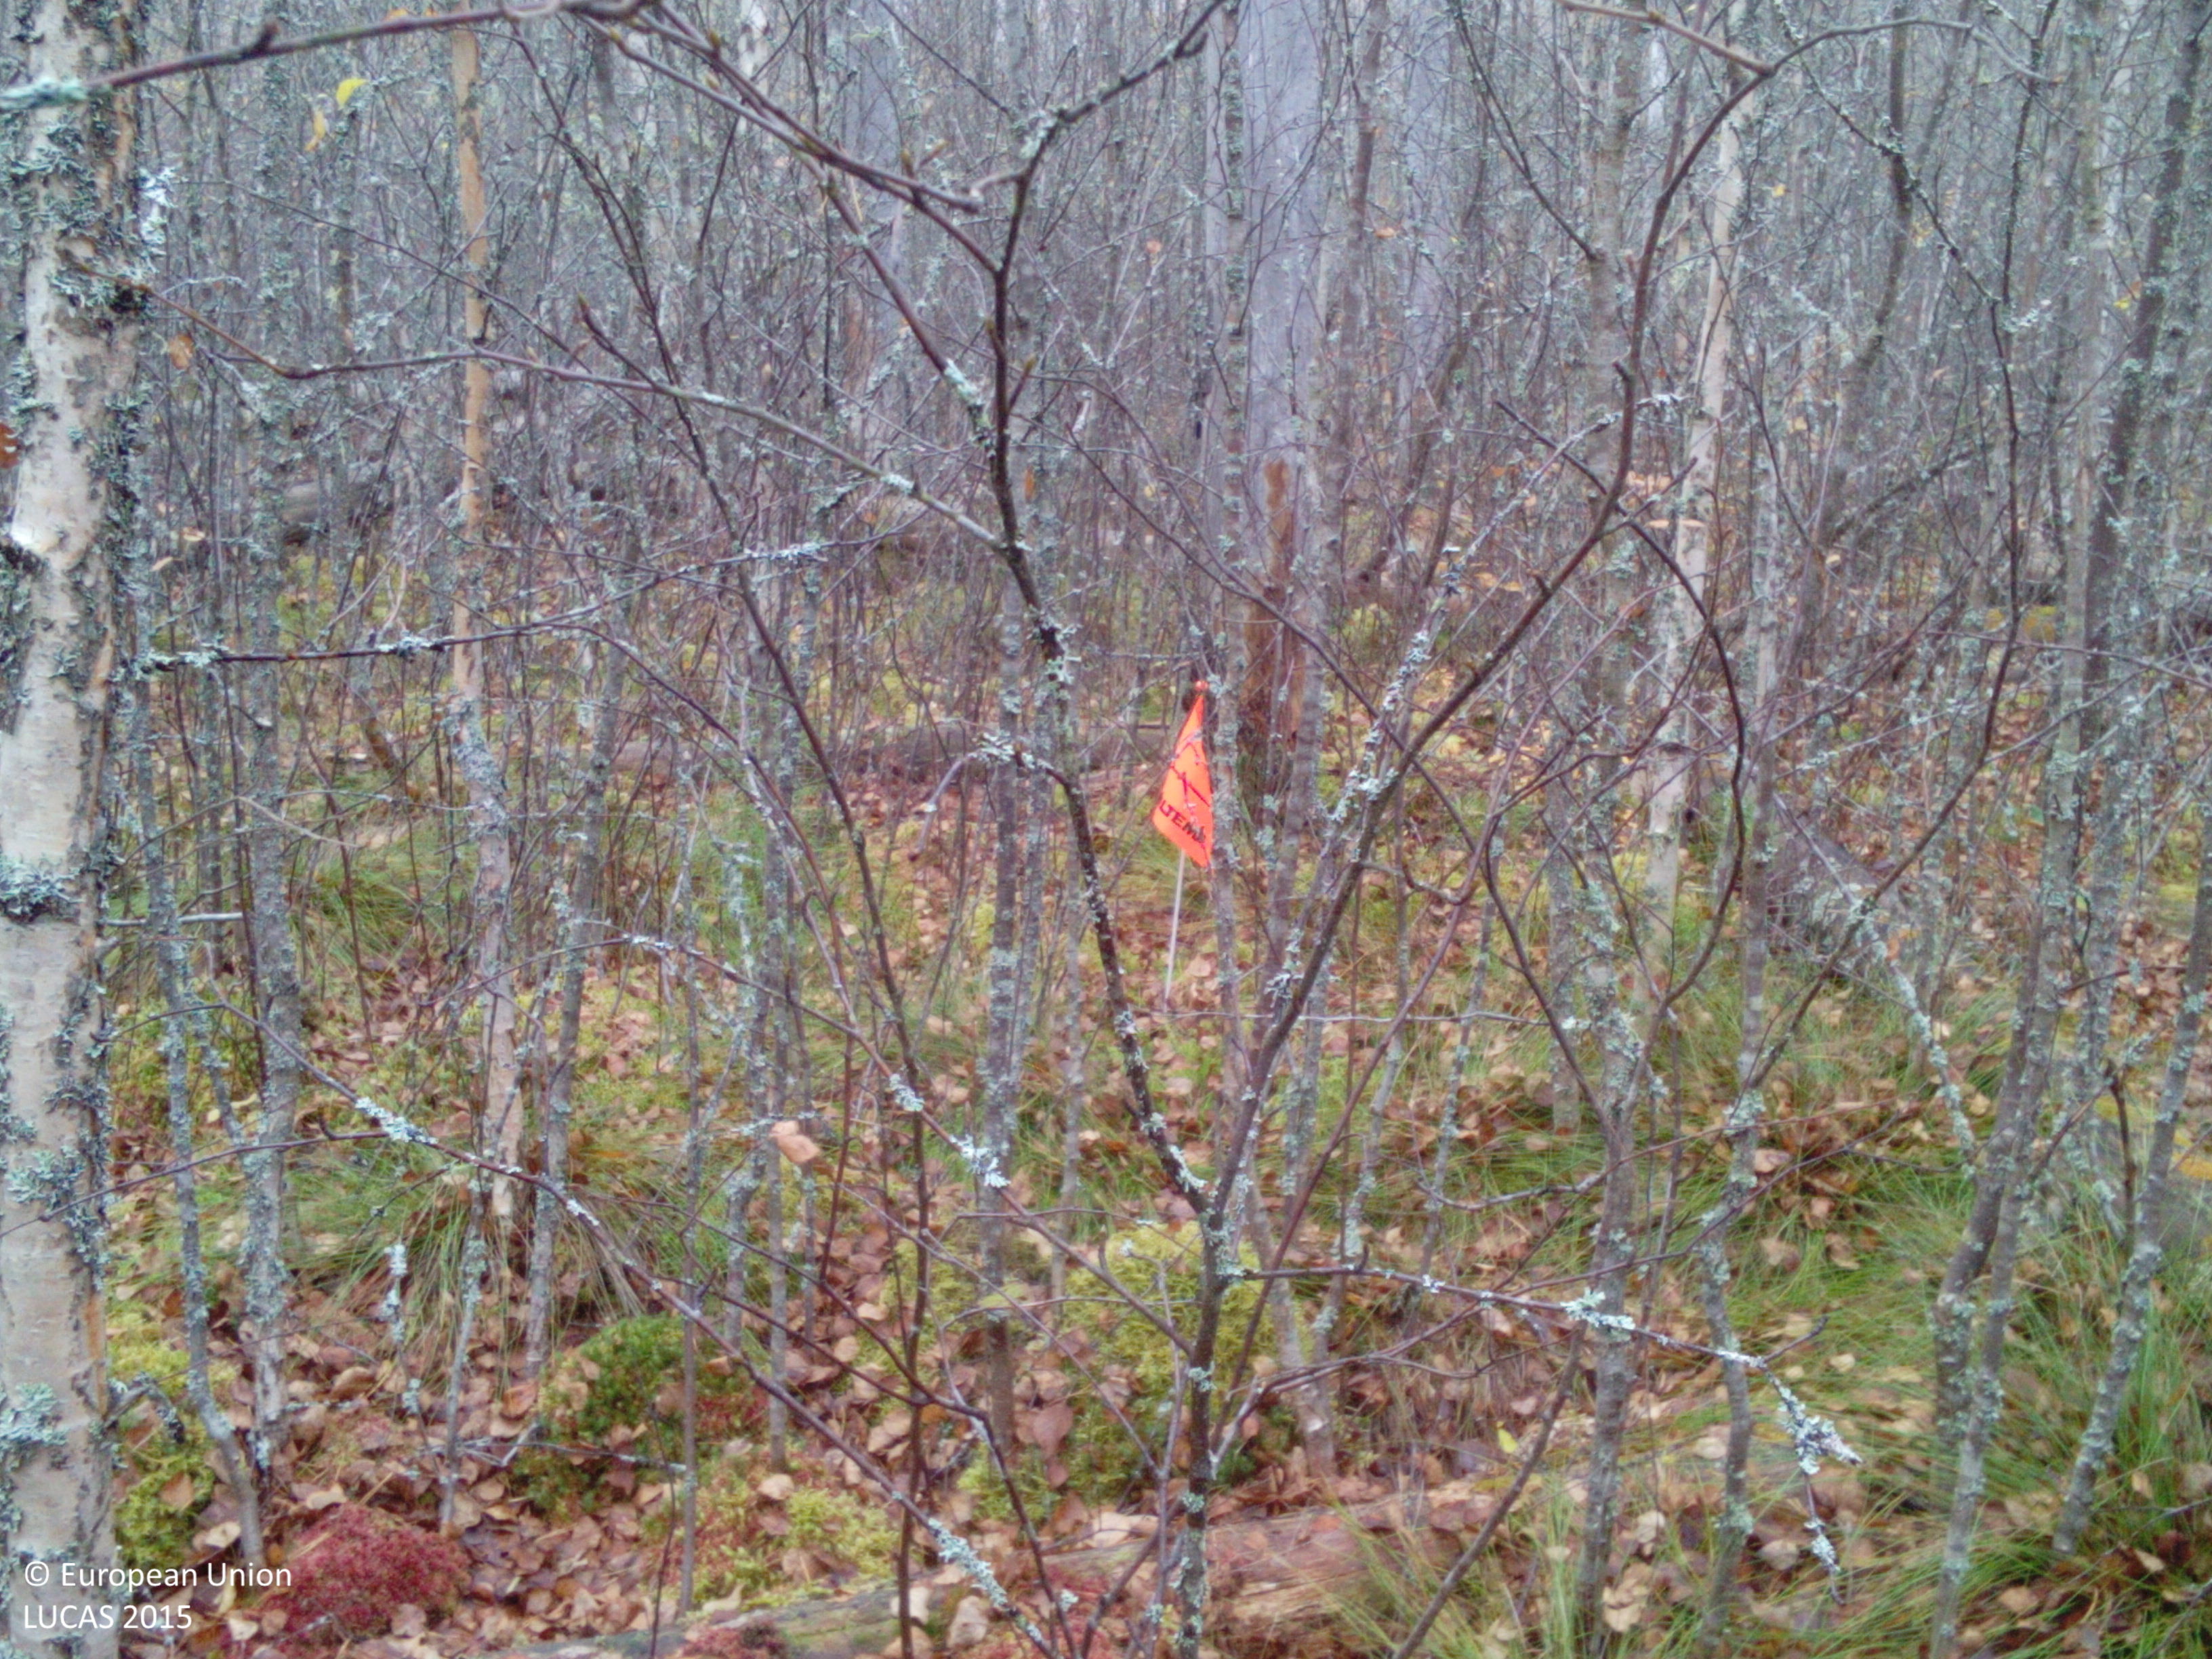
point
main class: Woodland
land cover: Broadleaved woodland
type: hemiboreal forest and nemoral coniferous forest and mixed broadleaved-coniferous forest
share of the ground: > 75 %
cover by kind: broadleaved forest trees 85 %, herbaceous plants 10 %, lichens and mosses 5 %
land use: Forestry
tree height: < 5 m
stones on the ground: < 10 %
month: October
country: SE
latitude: 58.9334
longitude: 16.4053
